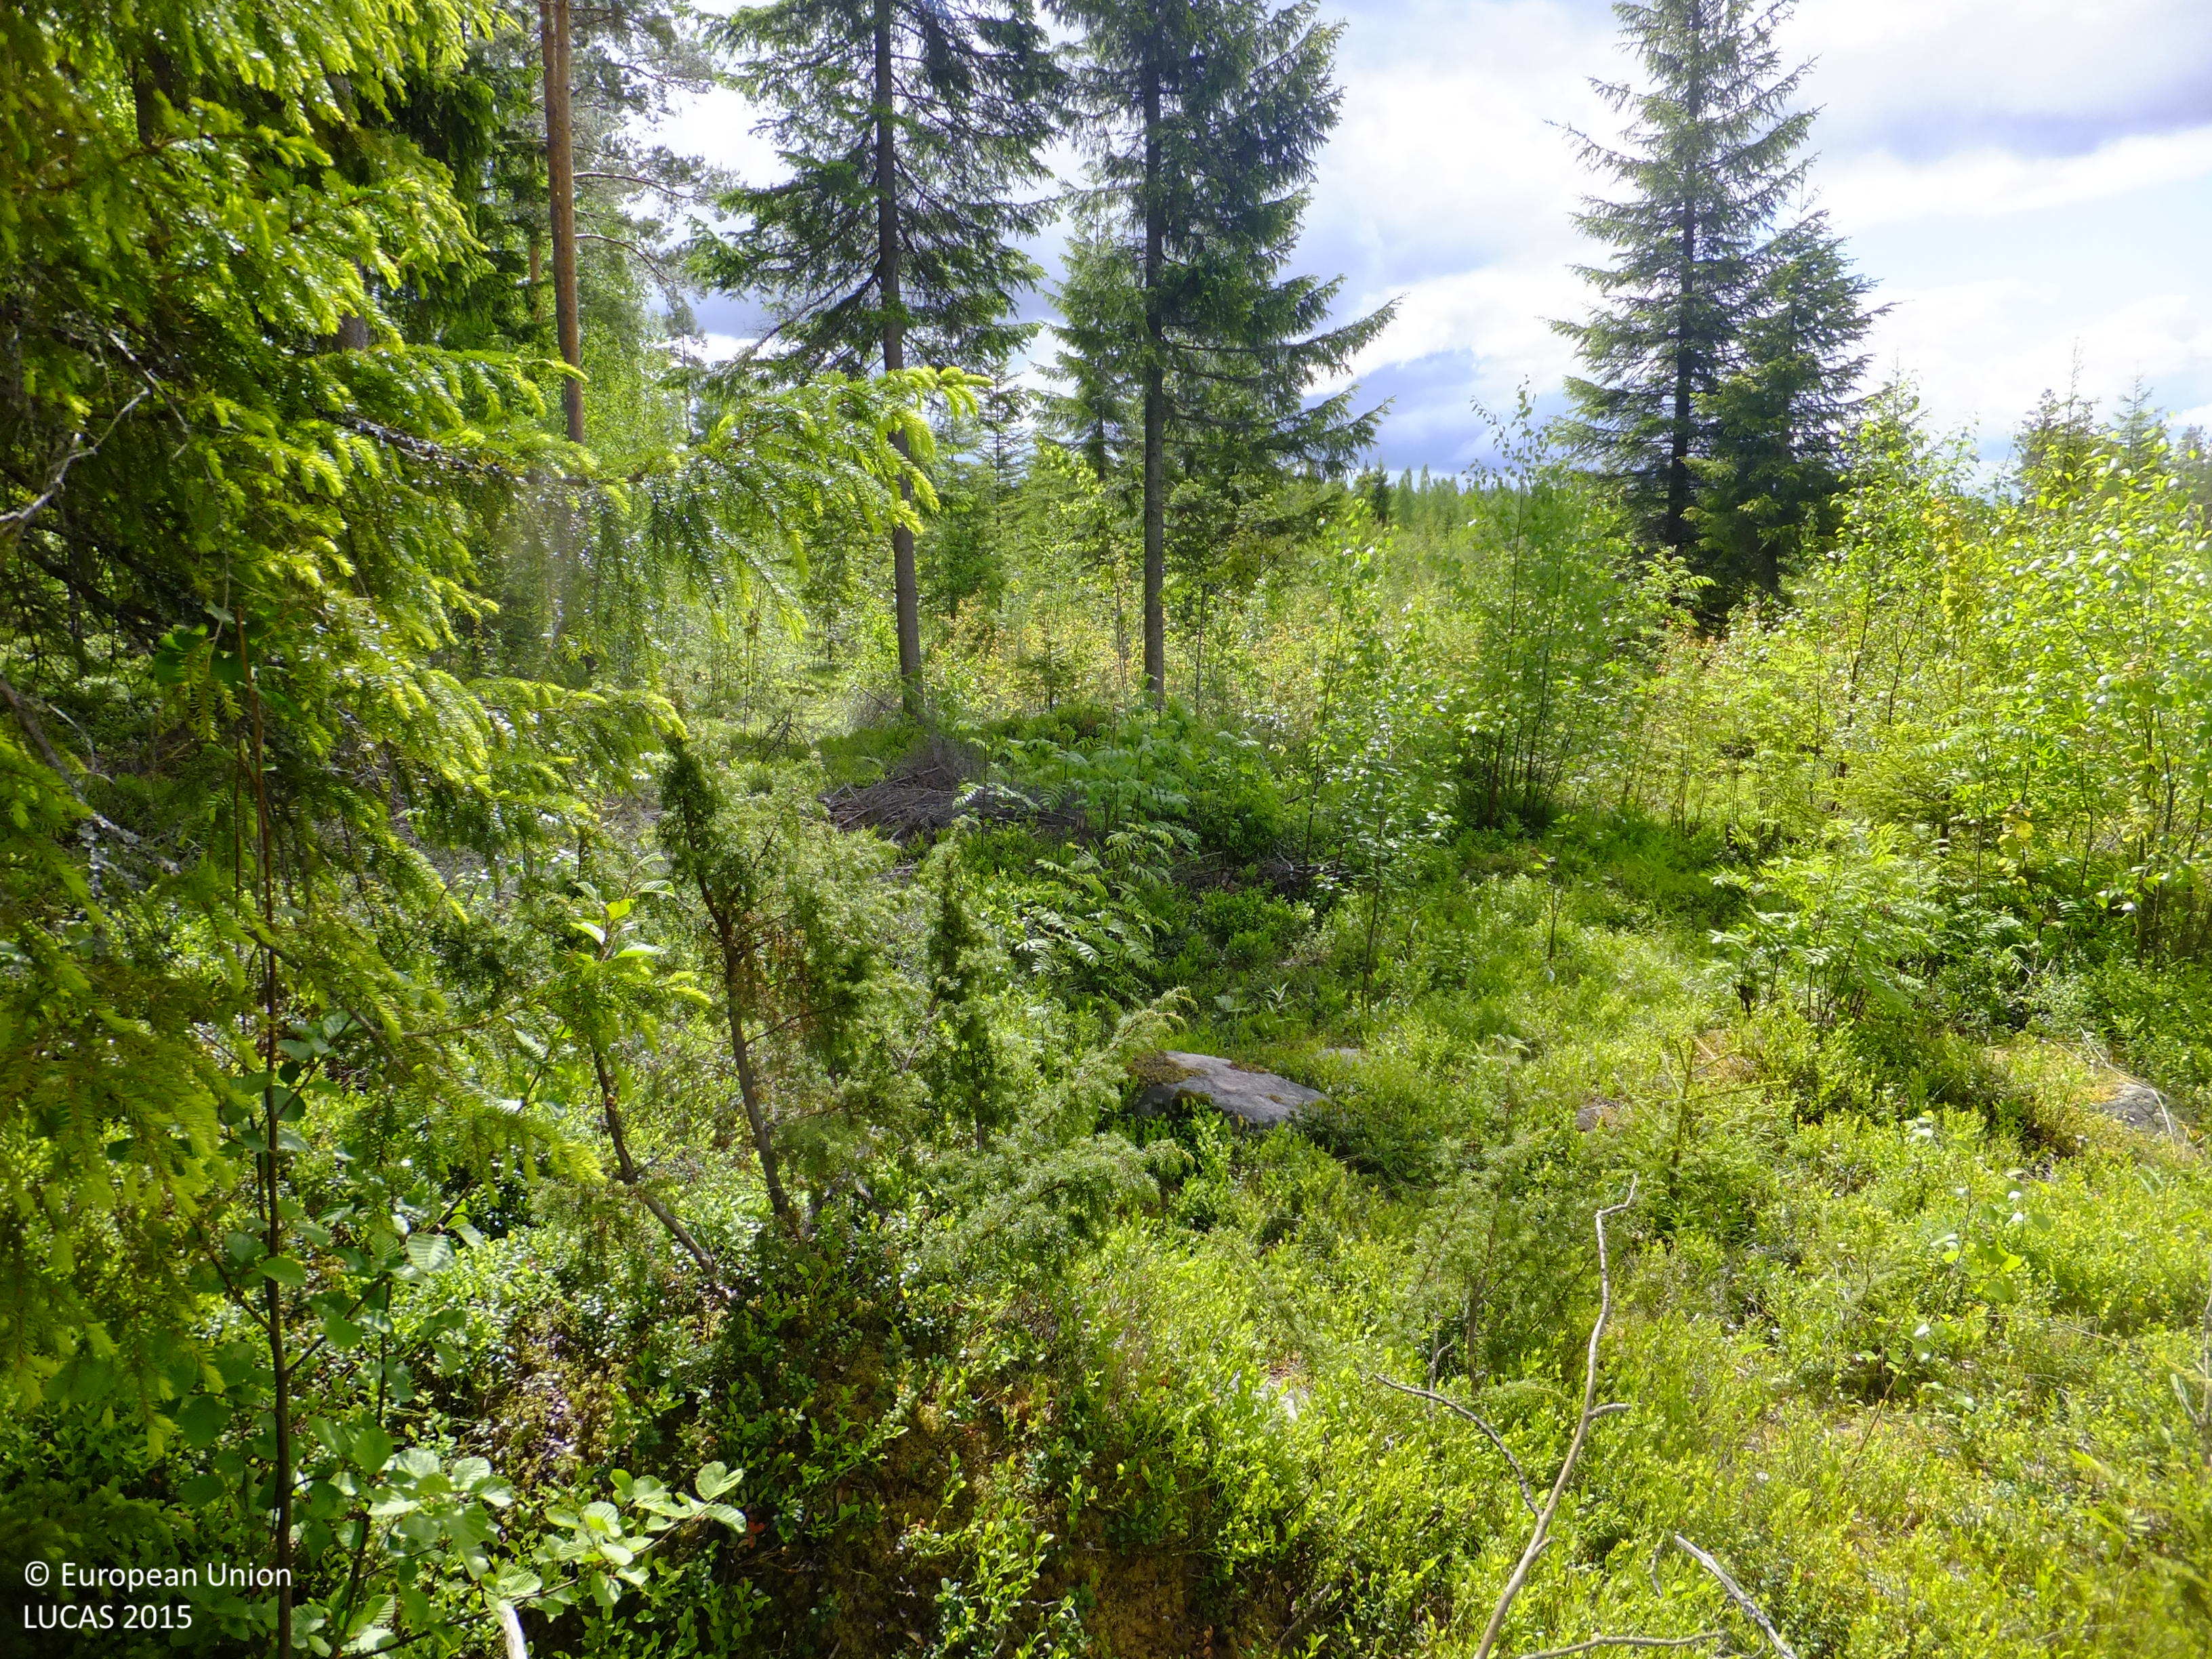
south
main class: Woodland
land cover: Other mixed woodland
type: boreal forest
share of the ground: 50 - 75 %
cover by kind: coniferous forest trees 50 %, shrubs 30 %, broadleaved forest trees 20 %
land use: Forestry
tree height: > 5 m
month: June
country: FI
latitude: 63.5692
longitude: 24.8052
